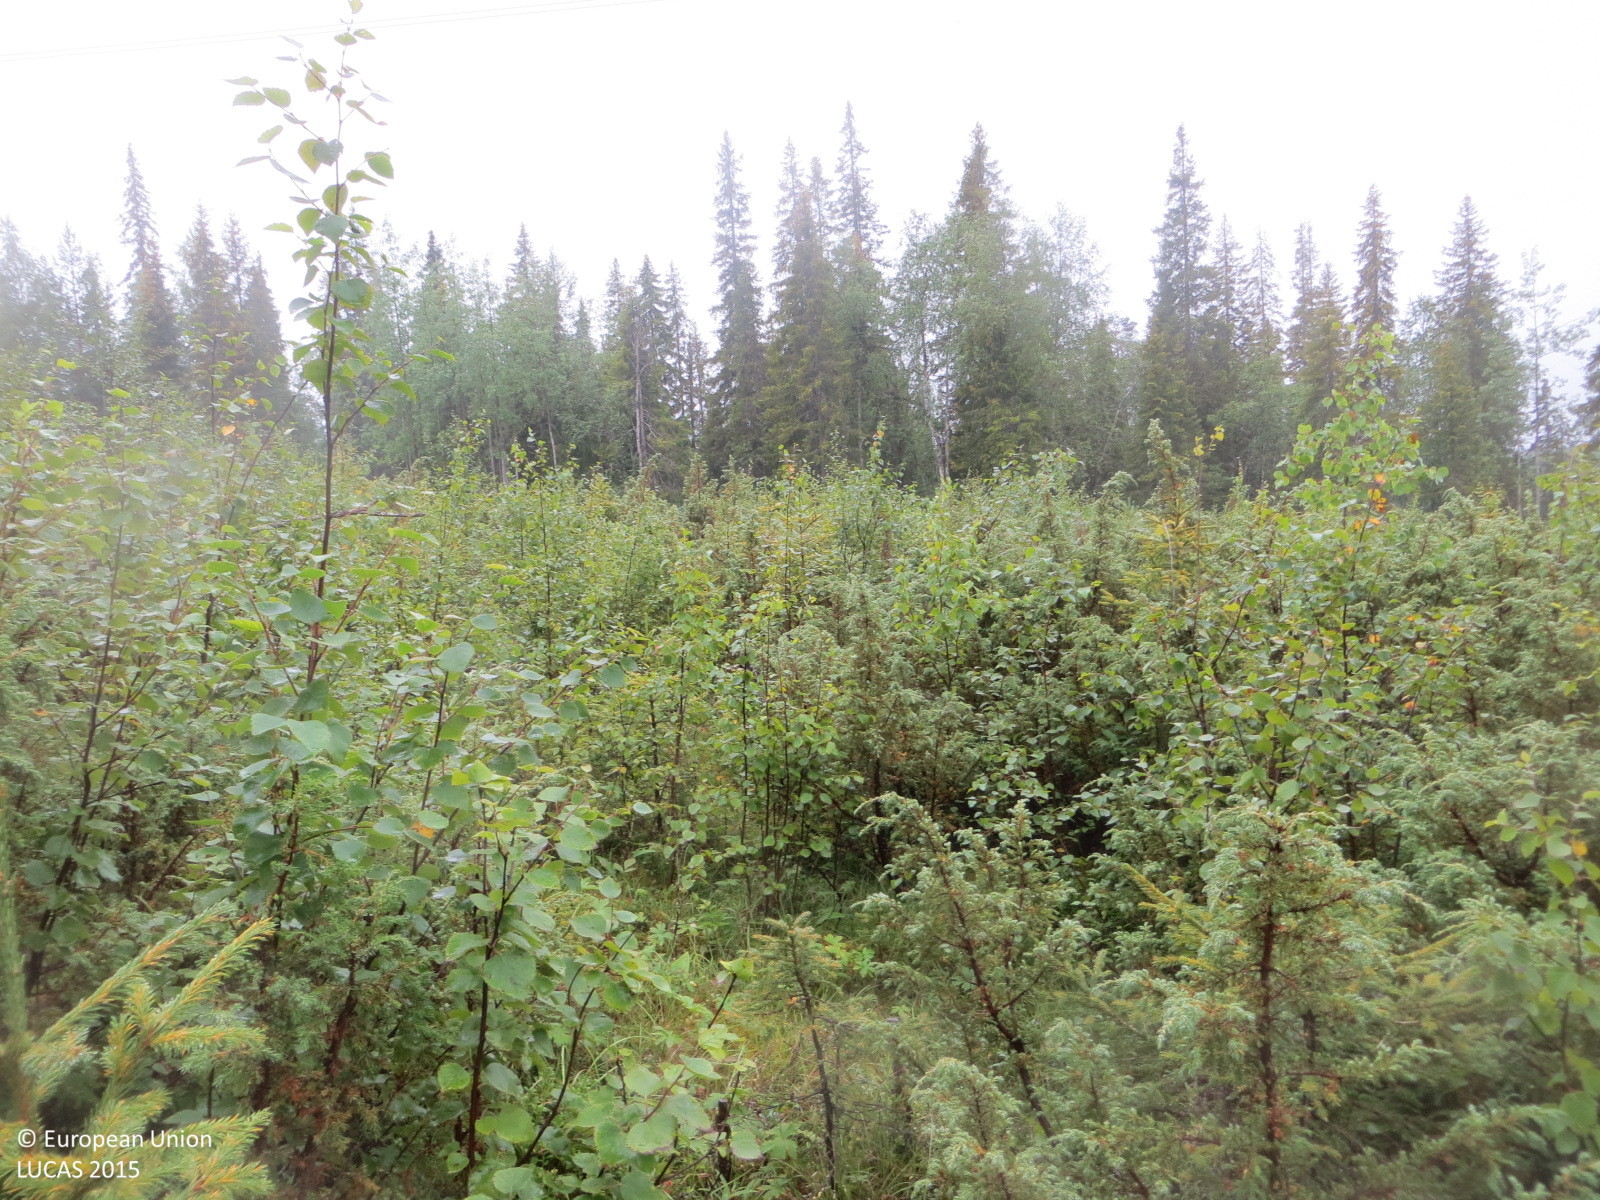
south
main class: Artificial land
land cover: Other artificial areas
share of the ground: > 75 %
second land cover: Other mixed woodland
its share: > 75 %
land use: Electricity, gas and thermal power distribution
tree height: < 5 m
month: August
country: FI
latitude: 66.0928
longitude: 25.4824
